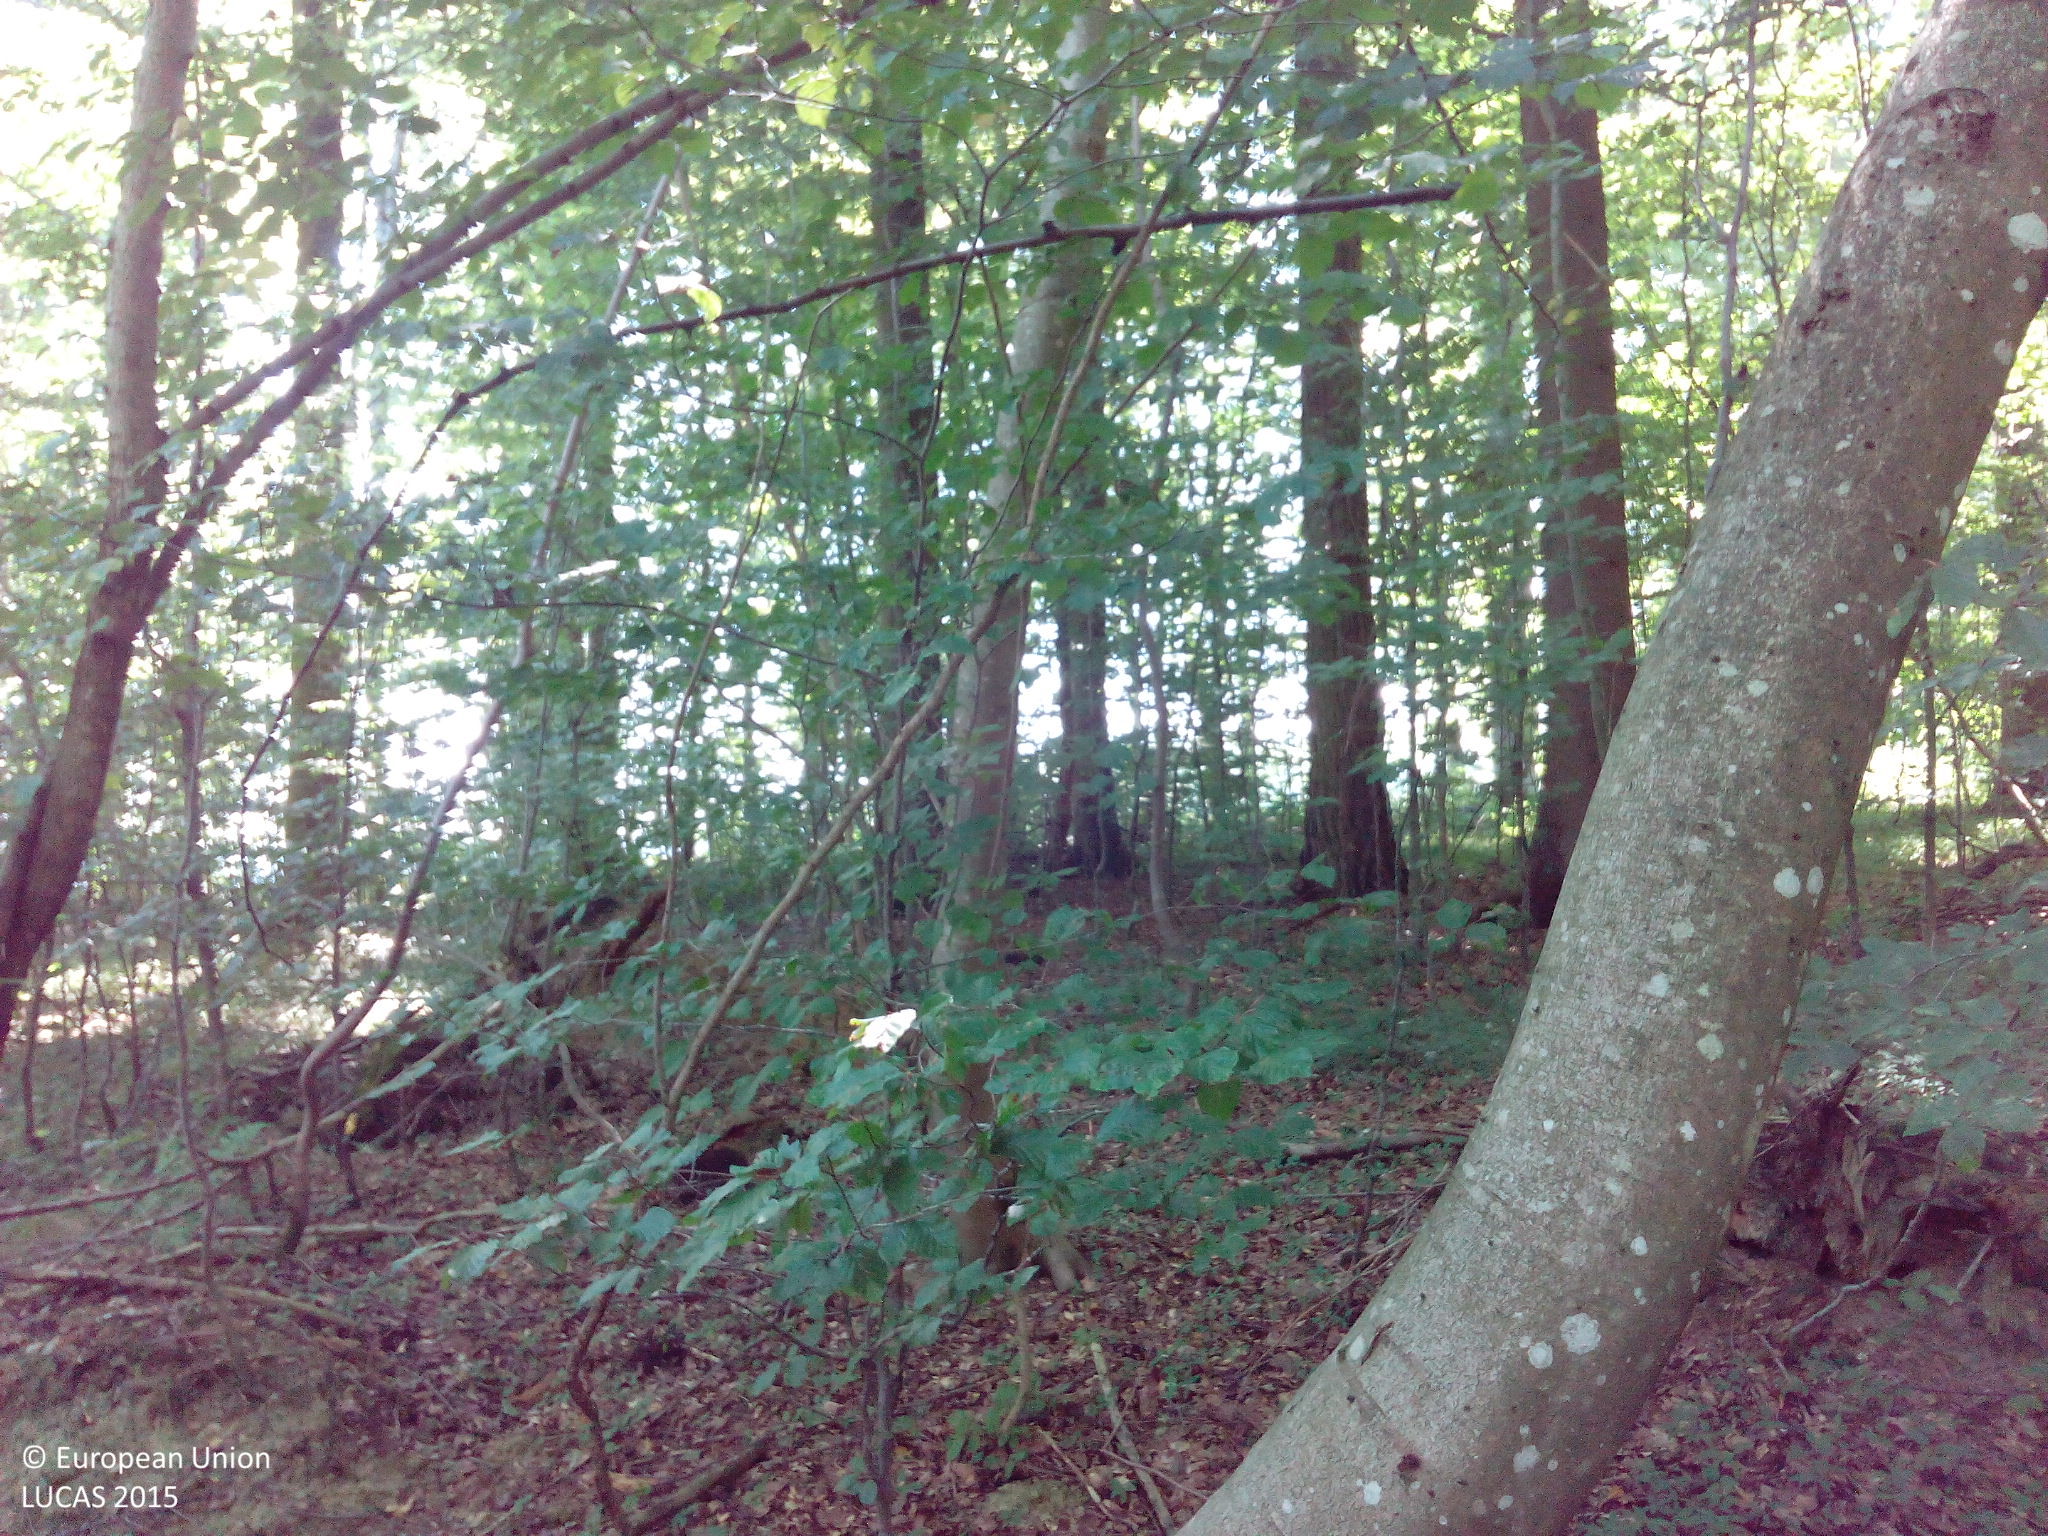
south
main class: Woodland
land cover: Broadleaved woodland
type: mesophytic deciduous forest
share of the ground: > 75 %
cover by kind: broadleaved forest trees 90 %, shrubs 5 %, unconsolidated bare surface 5 %
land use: Forestry
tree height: > 5 m
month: August
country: DE
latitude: 48.6551
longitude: 10.2578
